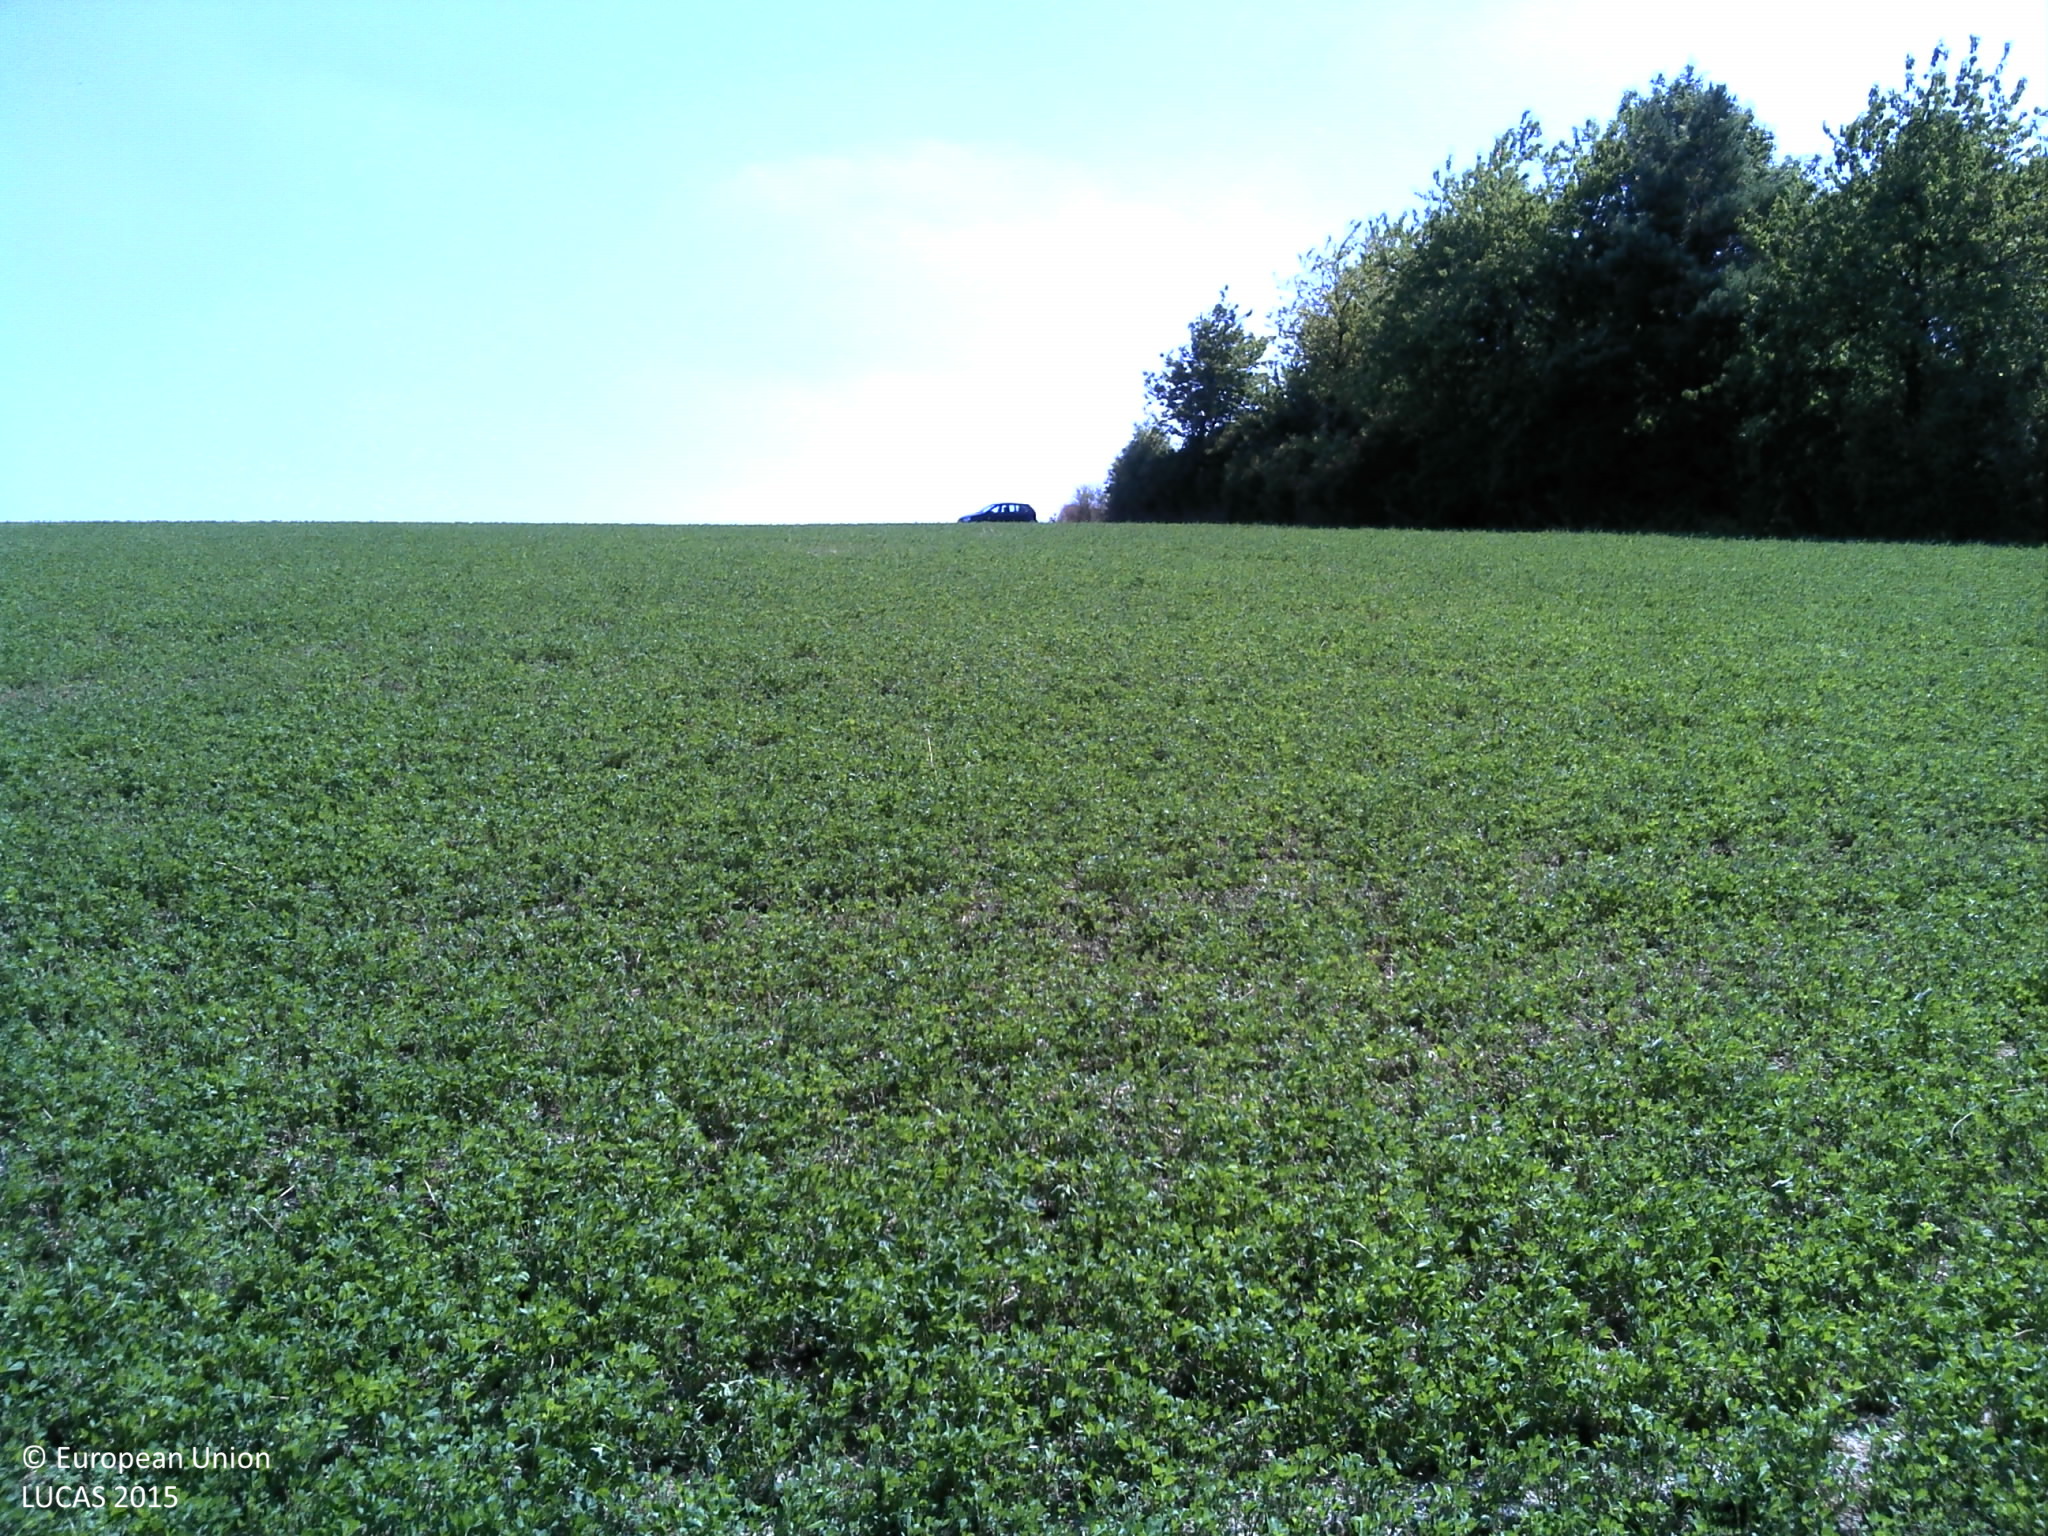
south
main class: Woodland
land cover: Spruce dominated mixed woodland
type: thermophilous deciduous forest
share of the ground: > 75 %
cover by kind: broadleaved forest trees 50 %, coniferous forest trees 25 %, herbaceous plants 20 %, shrubs 5 %
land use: Semi-natural and natural areas not in use
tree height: > 5 m
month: August
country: FR
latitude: 48.9096
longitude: 4.7444
